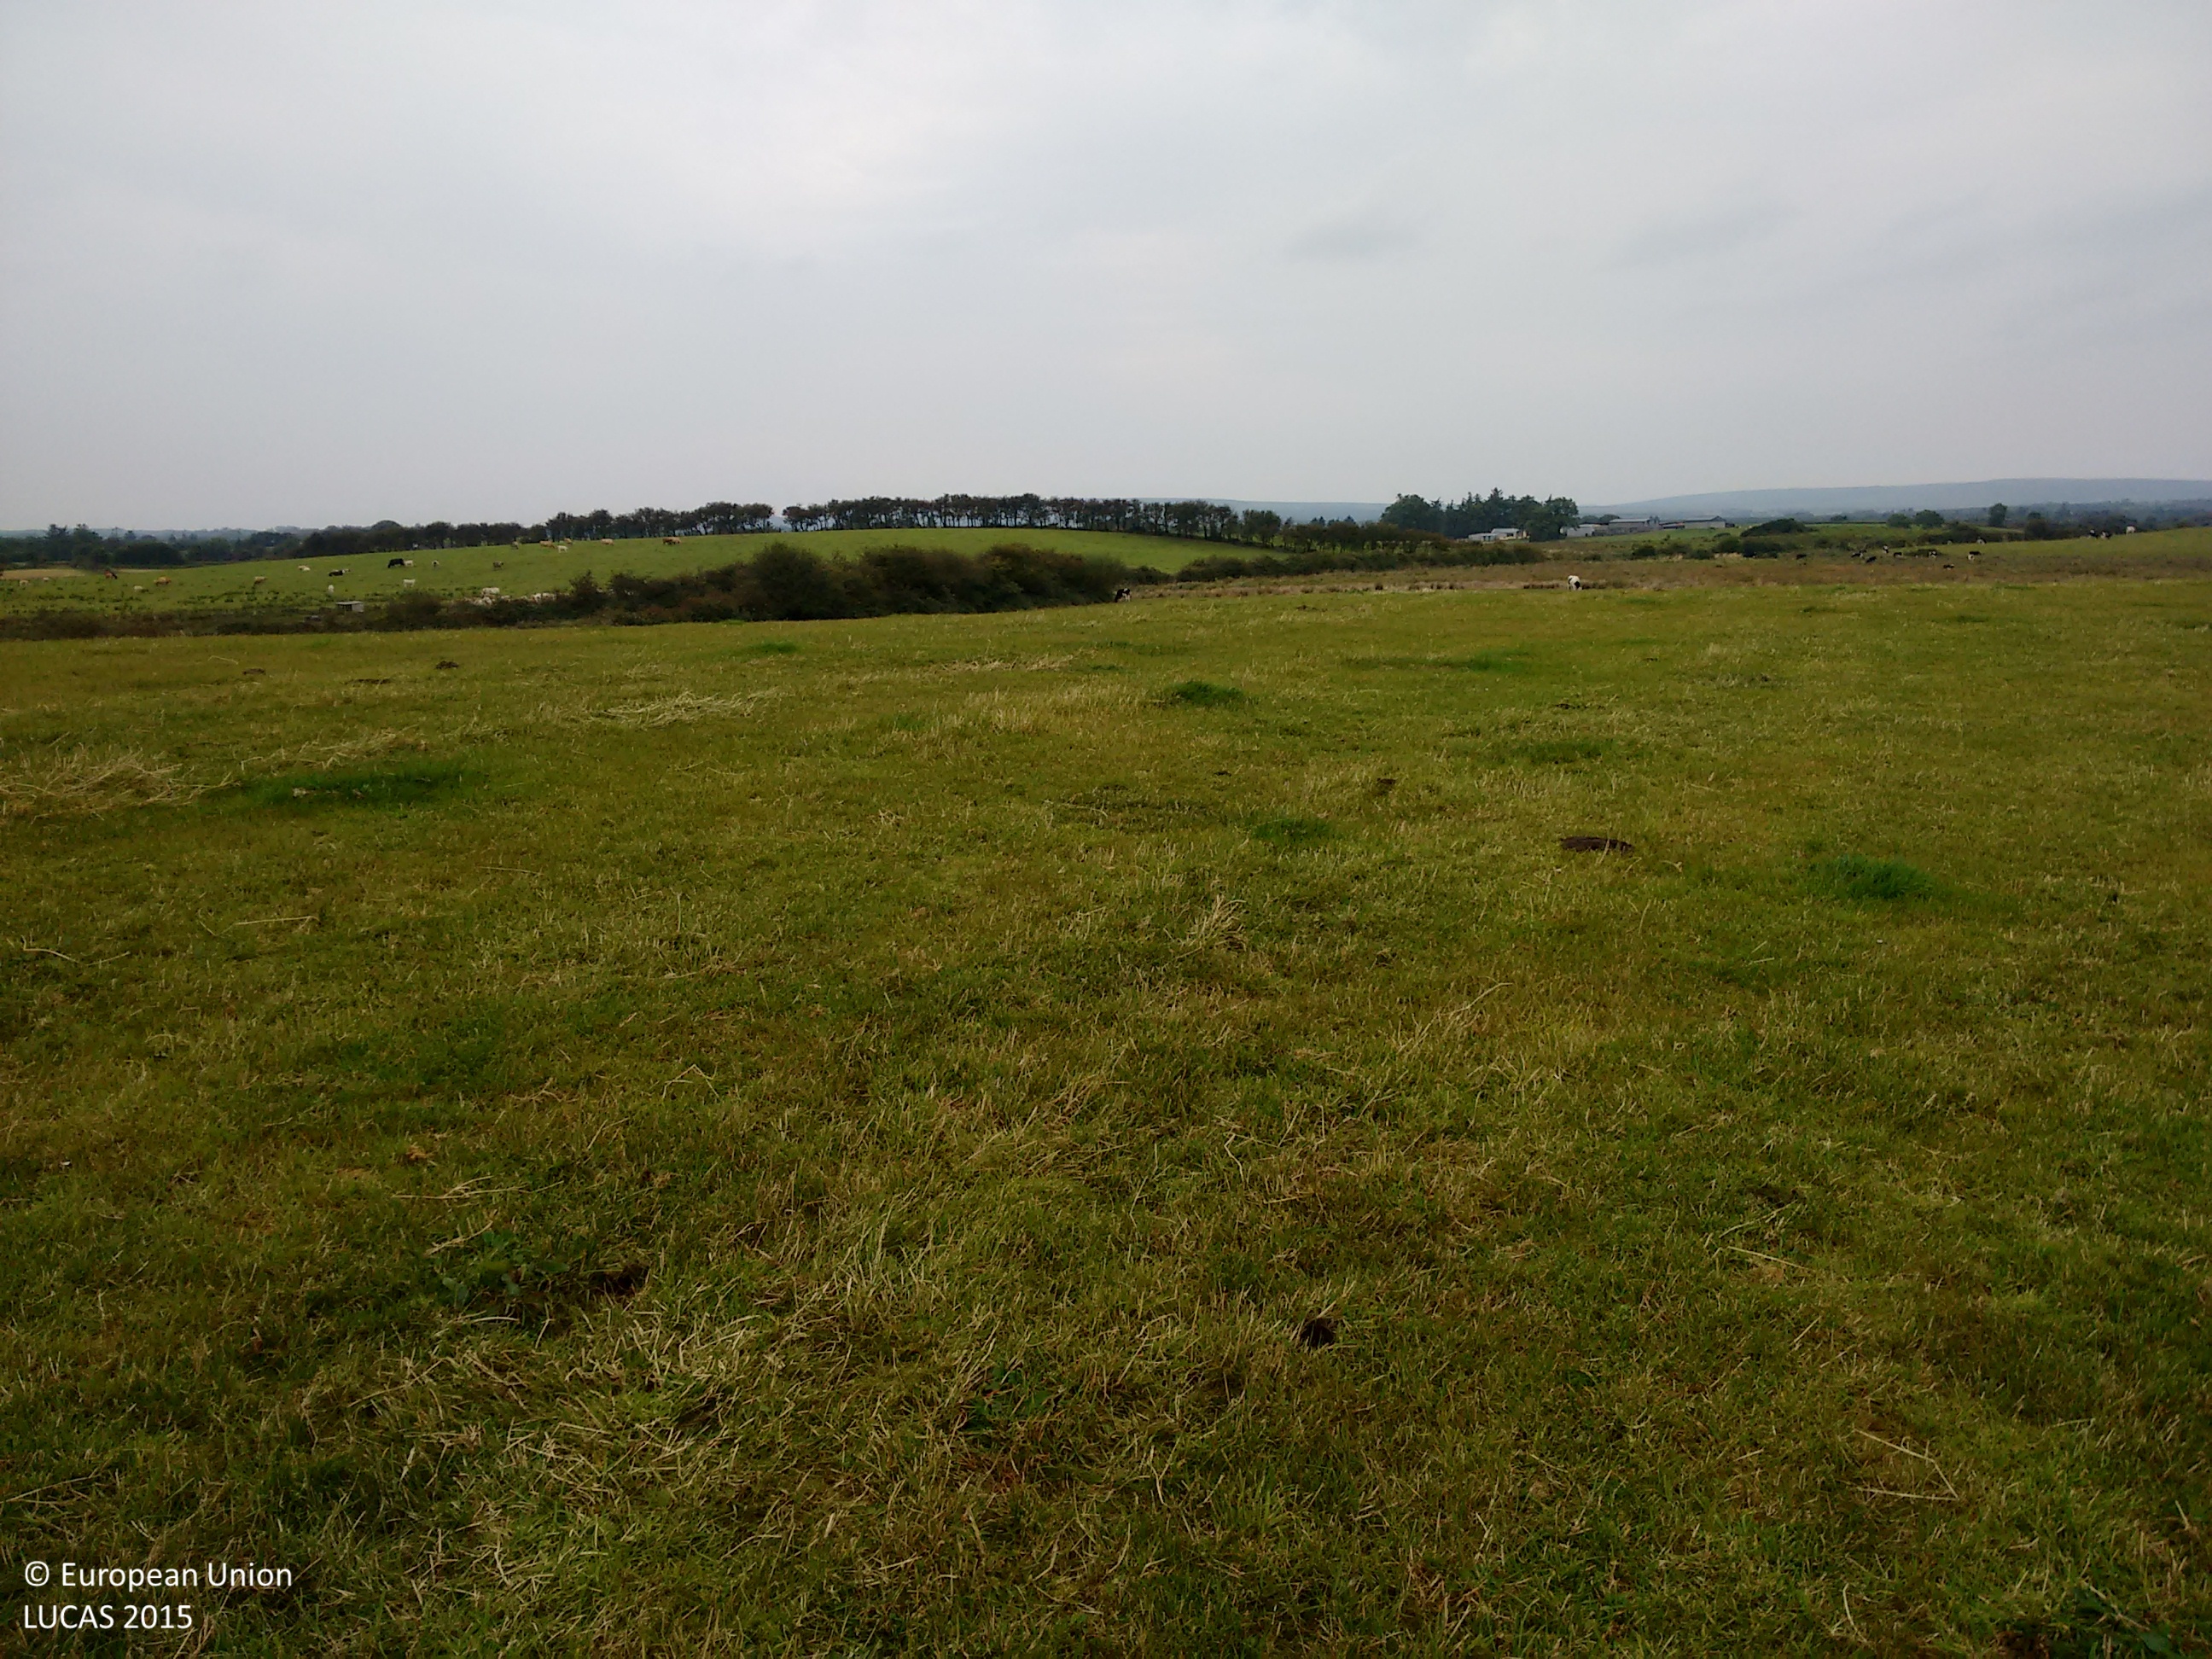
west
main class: Grassland
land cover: Grassland without tree/shrub cover
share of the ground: > 75 %
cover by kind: herbaceous plants 100 %
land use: Agriculture (excluding fallow land and kitchen gardens)
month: September
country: IE
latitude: 54.1977
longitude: -9.3073
